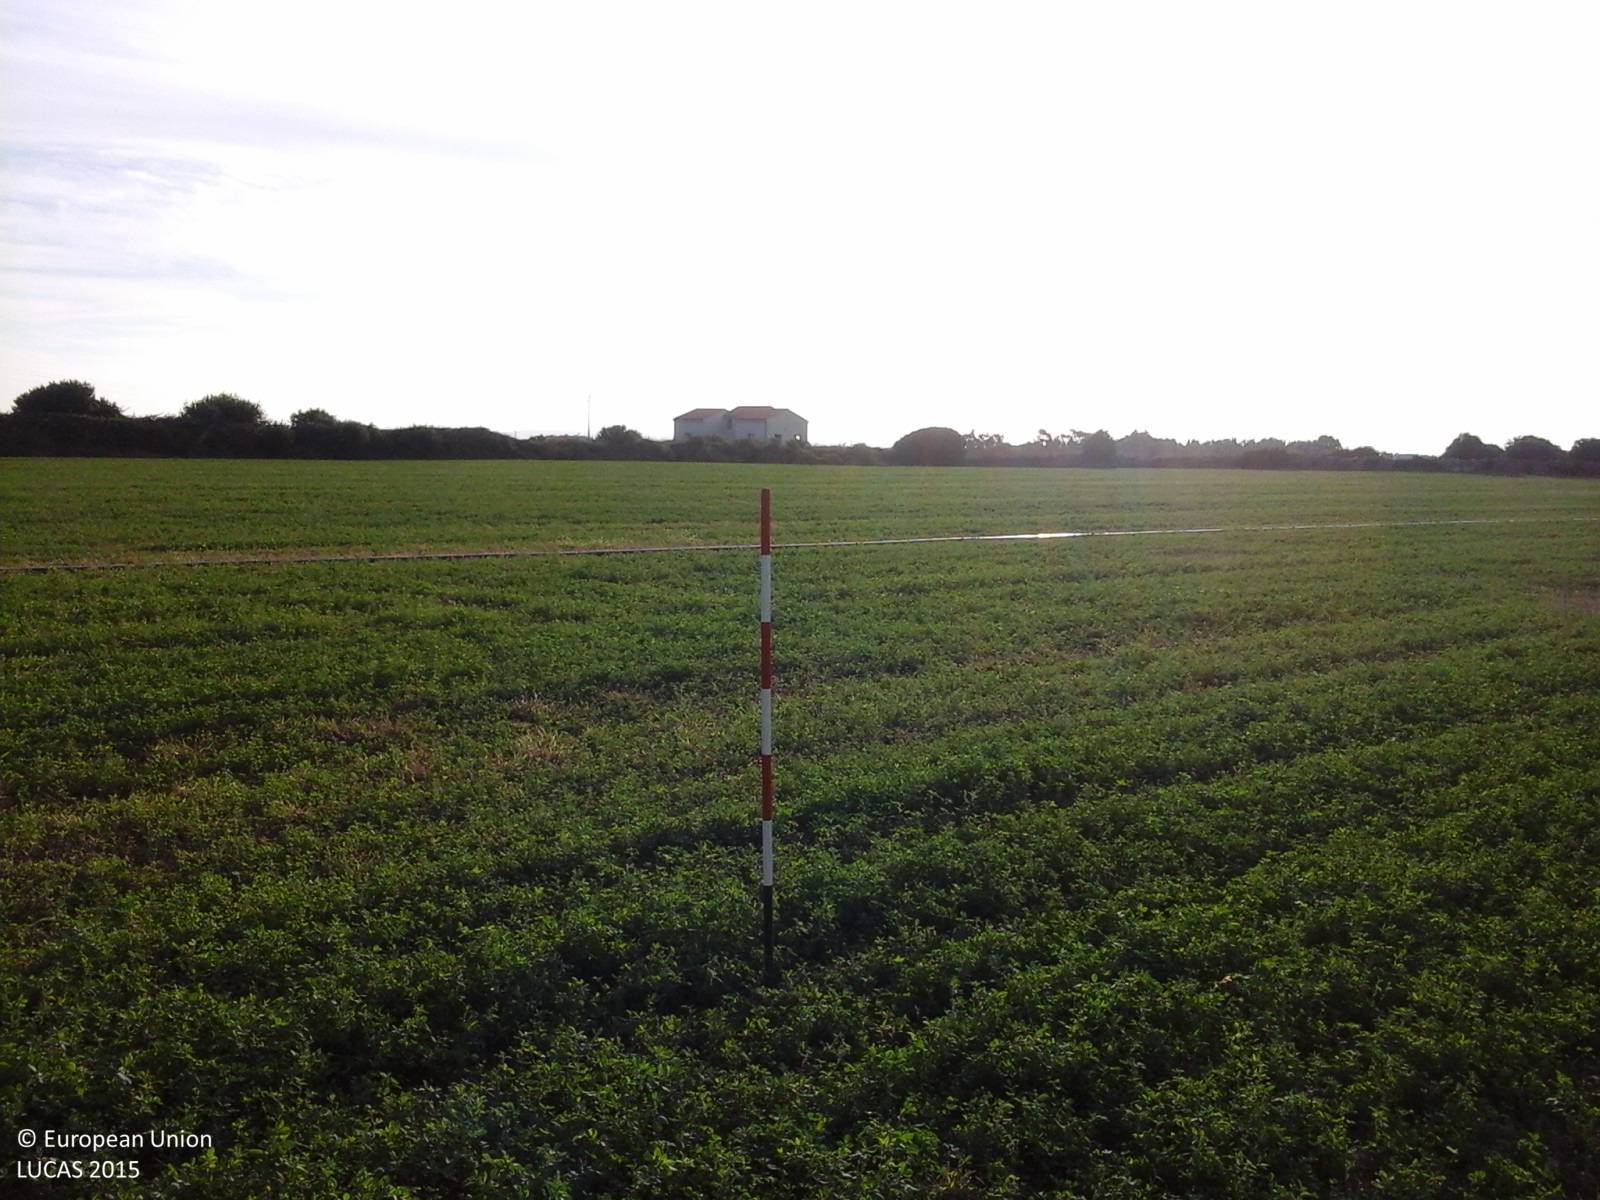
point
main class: Cropland
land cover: Lucerne
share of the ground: > 75 %
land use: Agriculture (excluding fallow land and kitchen gardens)
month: September
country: IT
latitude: 40.0023
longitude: 8.4971
